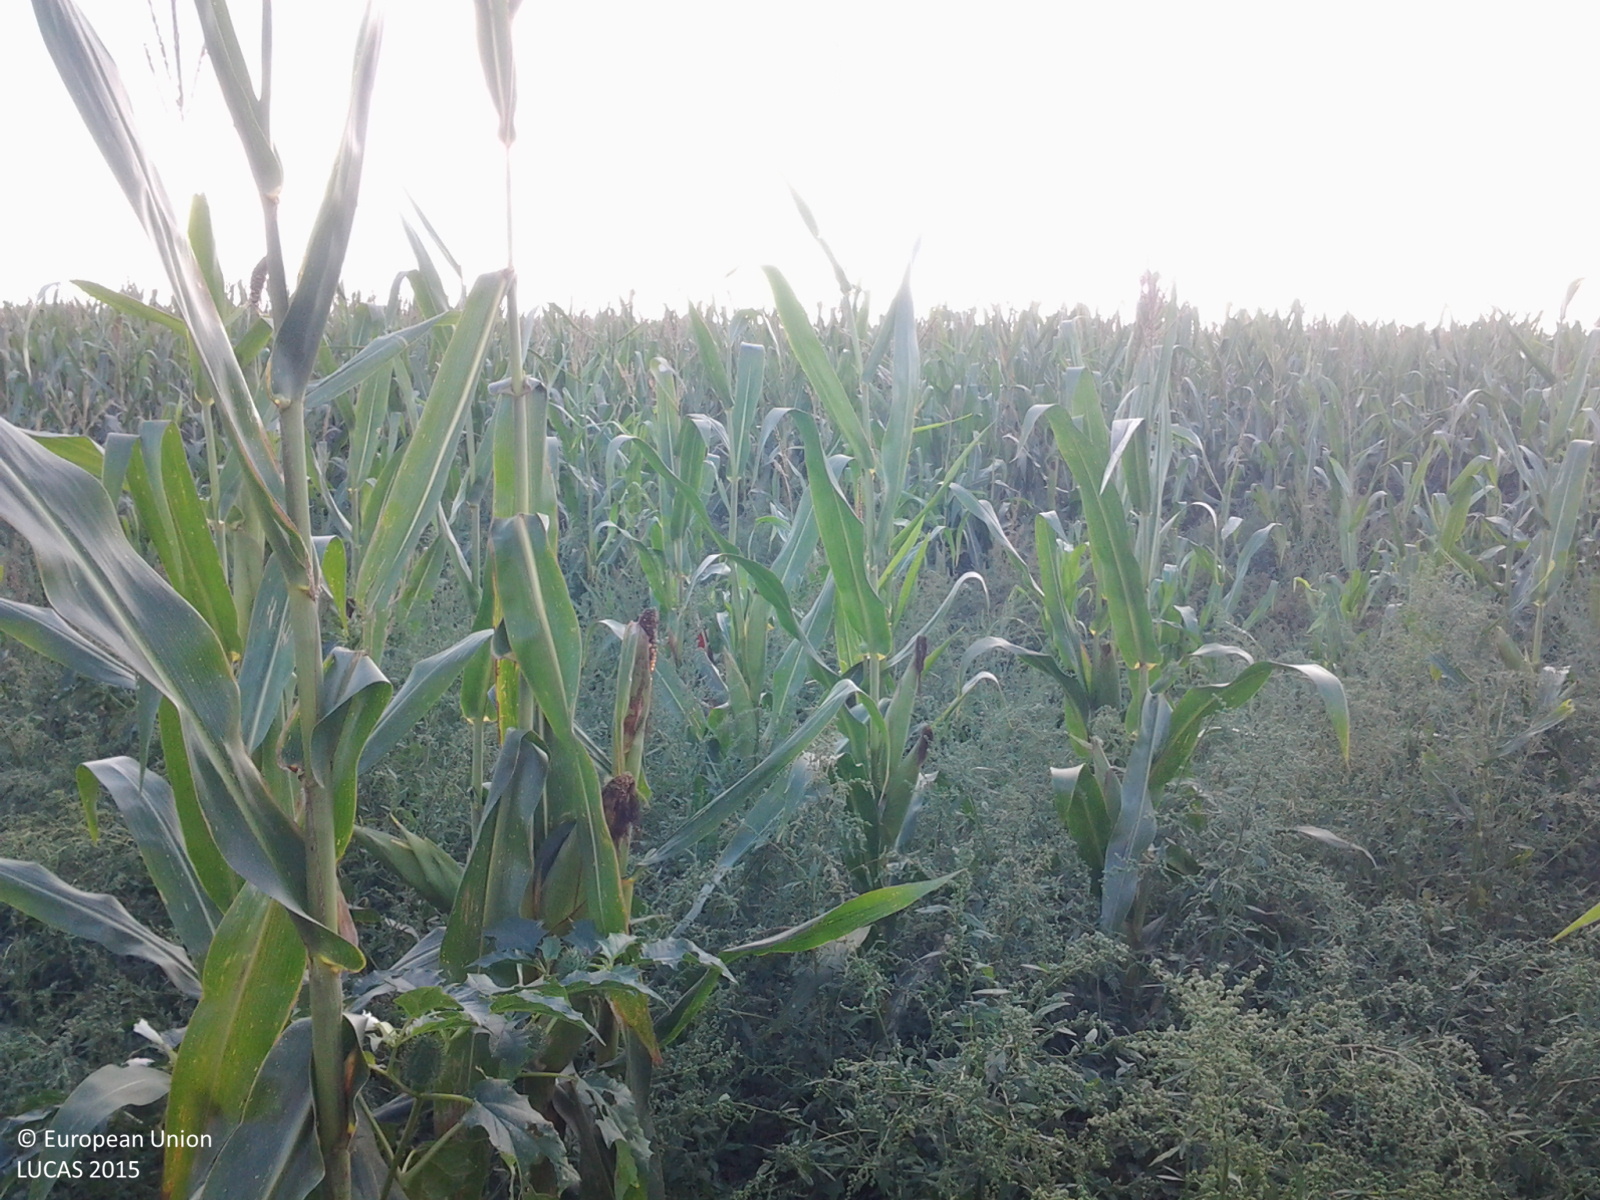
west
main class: Cropland
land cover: Maize
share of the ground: > 75 %
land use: Agriculture (excluding fallow land and kitchen gardens)
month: September
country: HU
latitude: 47.5632
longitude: 20.2496
